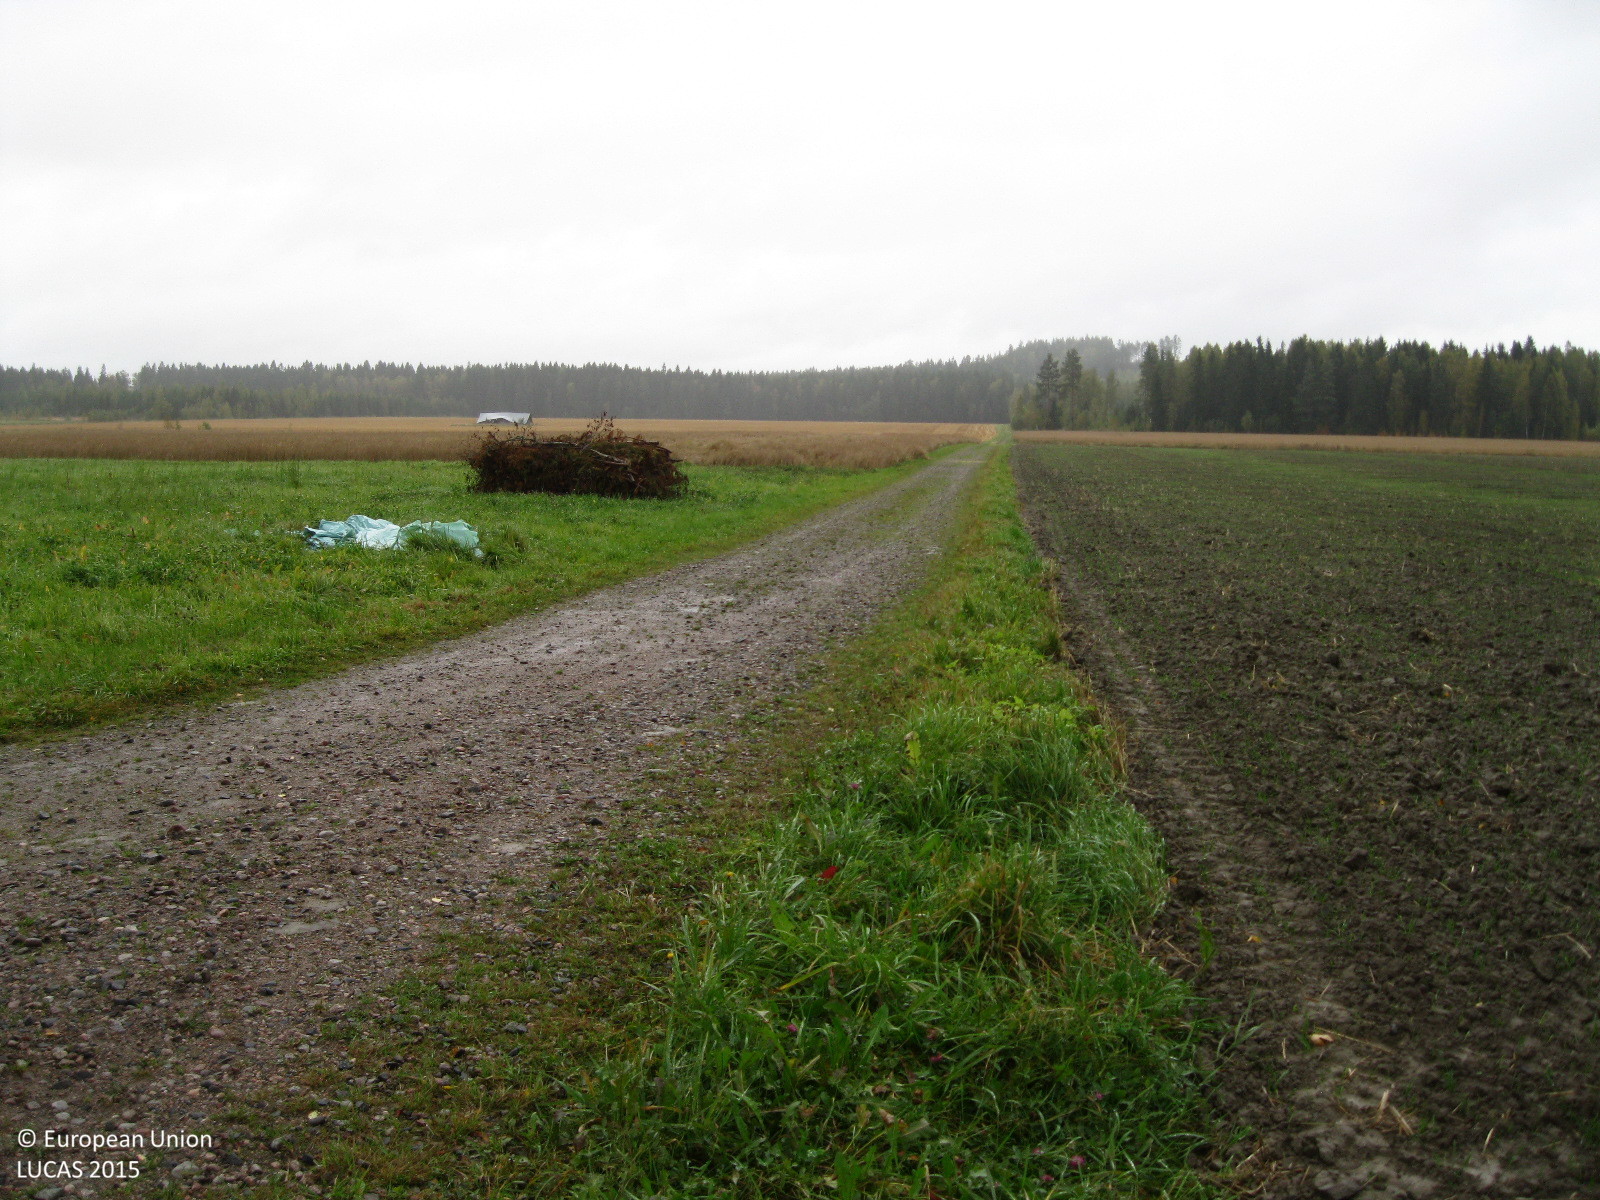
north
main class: Cropland
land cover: Common wheat
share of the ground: < 10 %
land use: Agriculture (excluding fallow land and kitchen gardens)
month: September
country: FI
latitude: 60.8160
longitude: 24.7246
